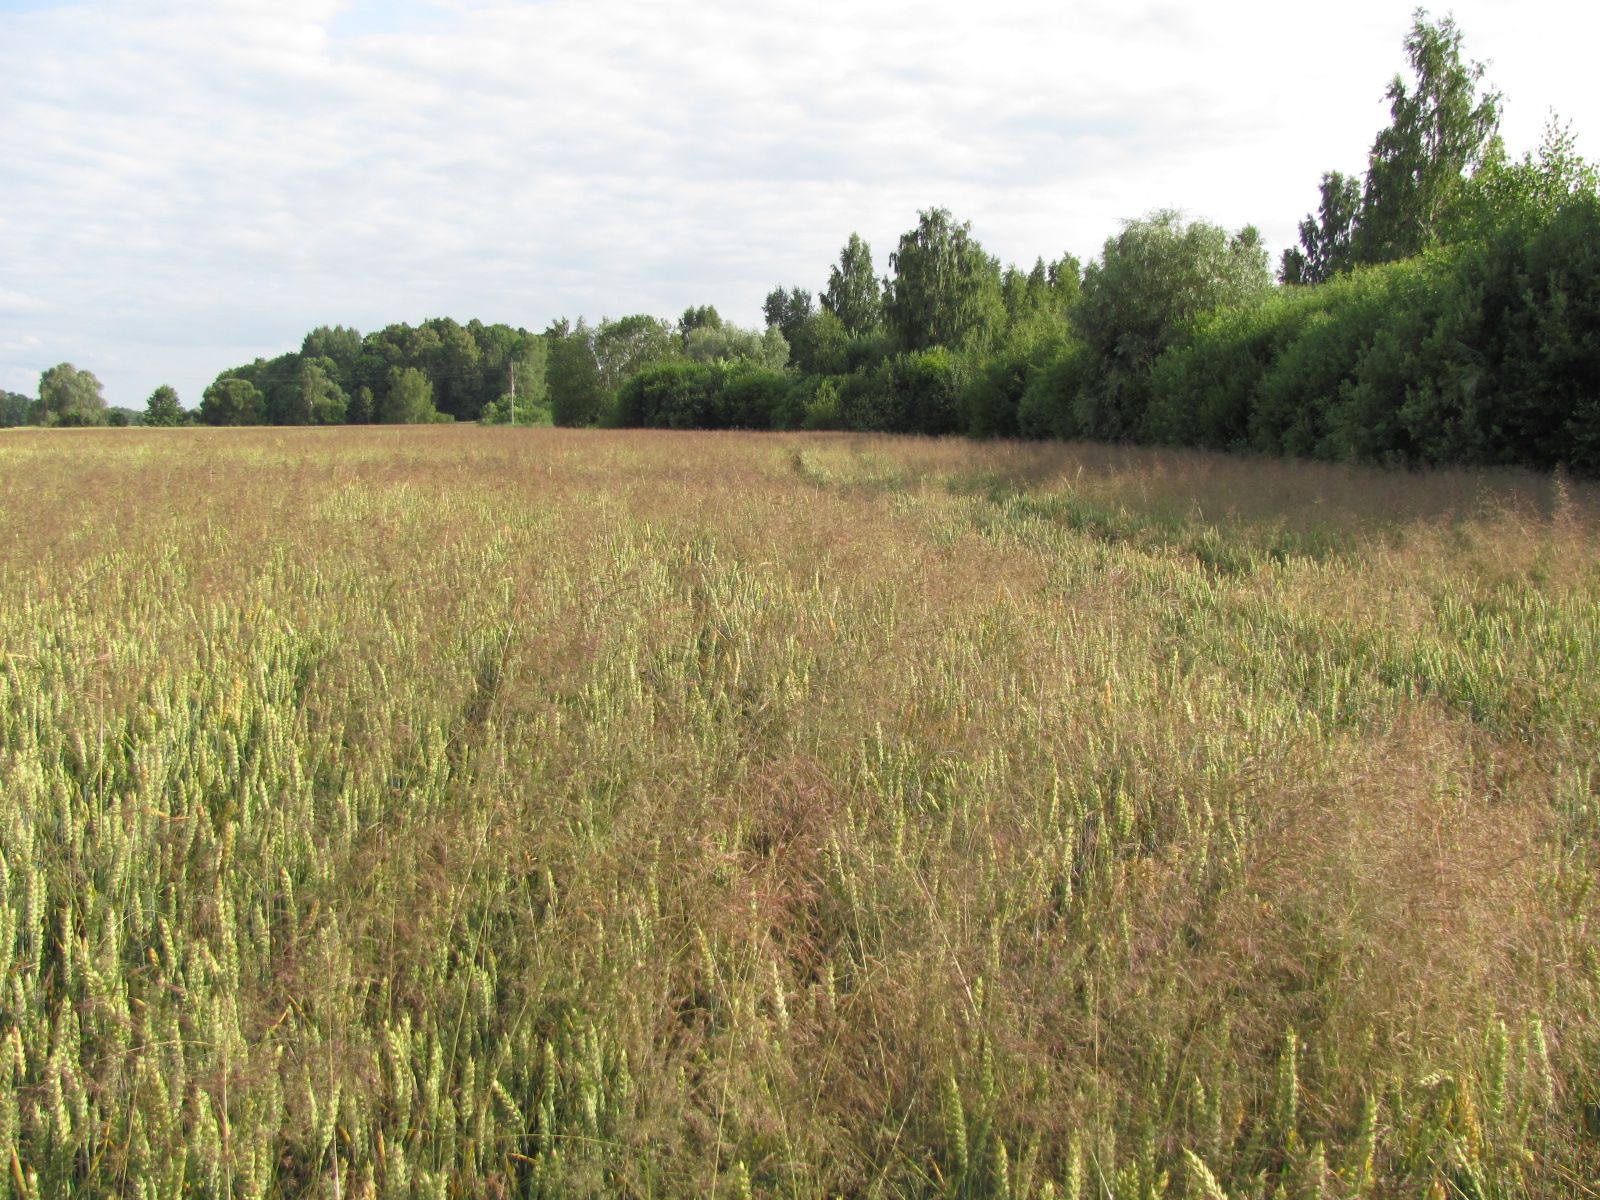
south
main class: Cropland
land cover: Common wheat
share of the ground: > 75 %
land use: Agriculture (excluding fallow land and kitchen gardens)
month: July
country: LV
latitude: 56.3561
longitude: 24.2522
